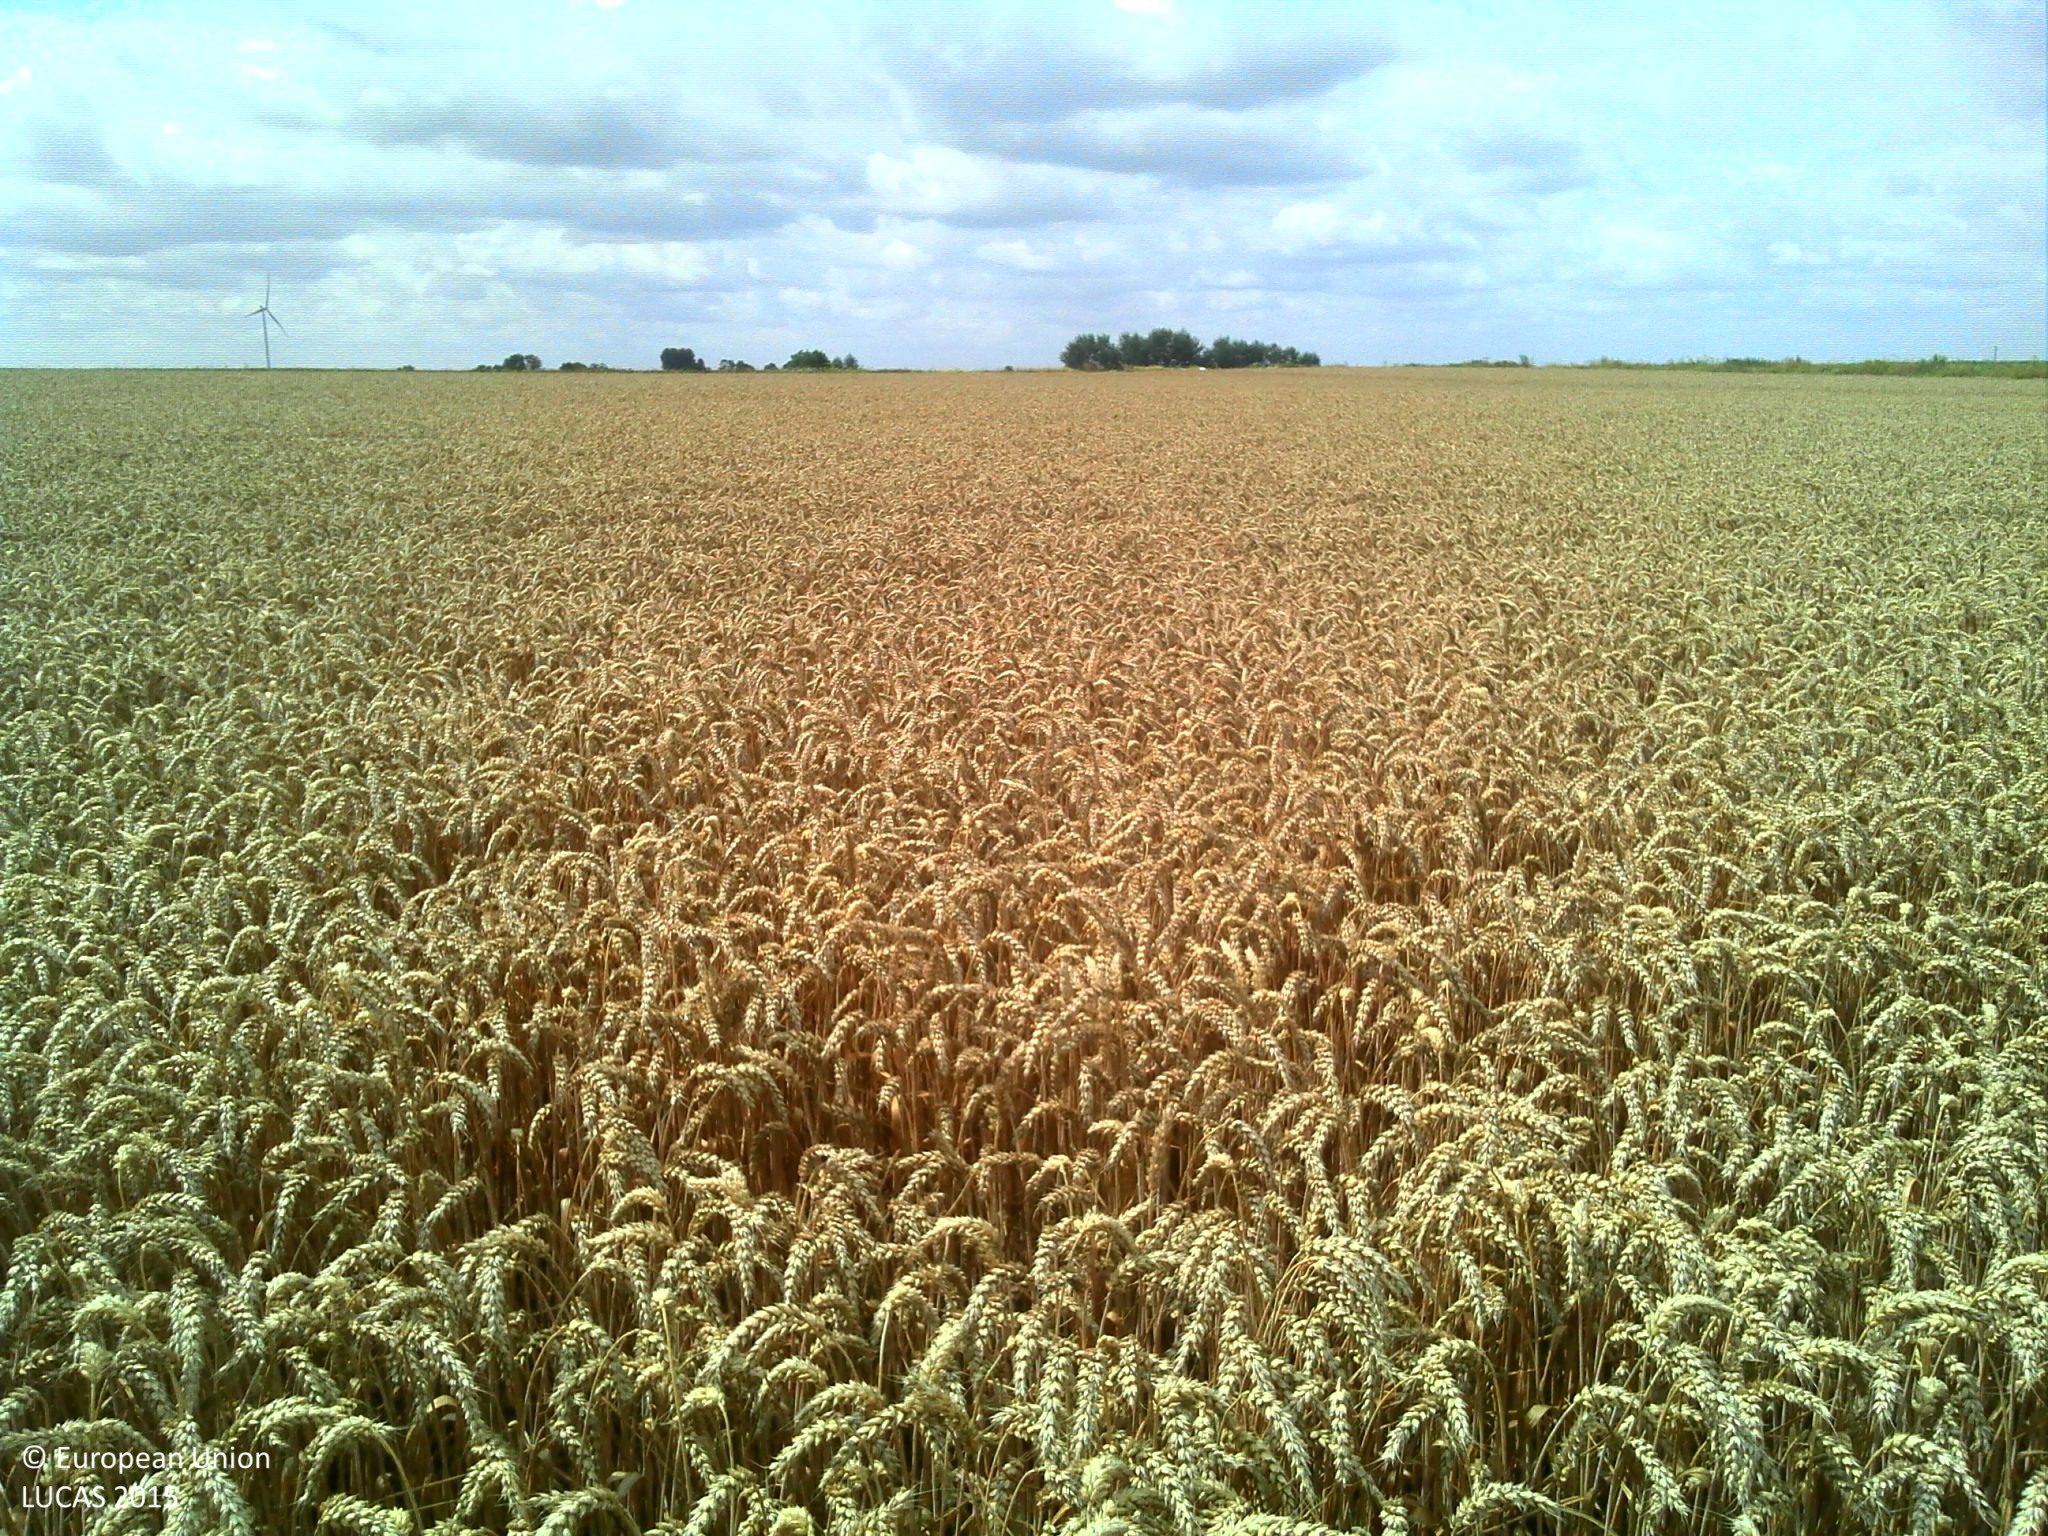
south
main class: Cropland
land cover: Common wheat
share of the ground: > 75 %
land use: Agriculture (excluding fallow land and kitchen gardens)
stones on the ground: < 10 %
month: July
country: FR
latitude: 49.9711
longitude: 3.6492
